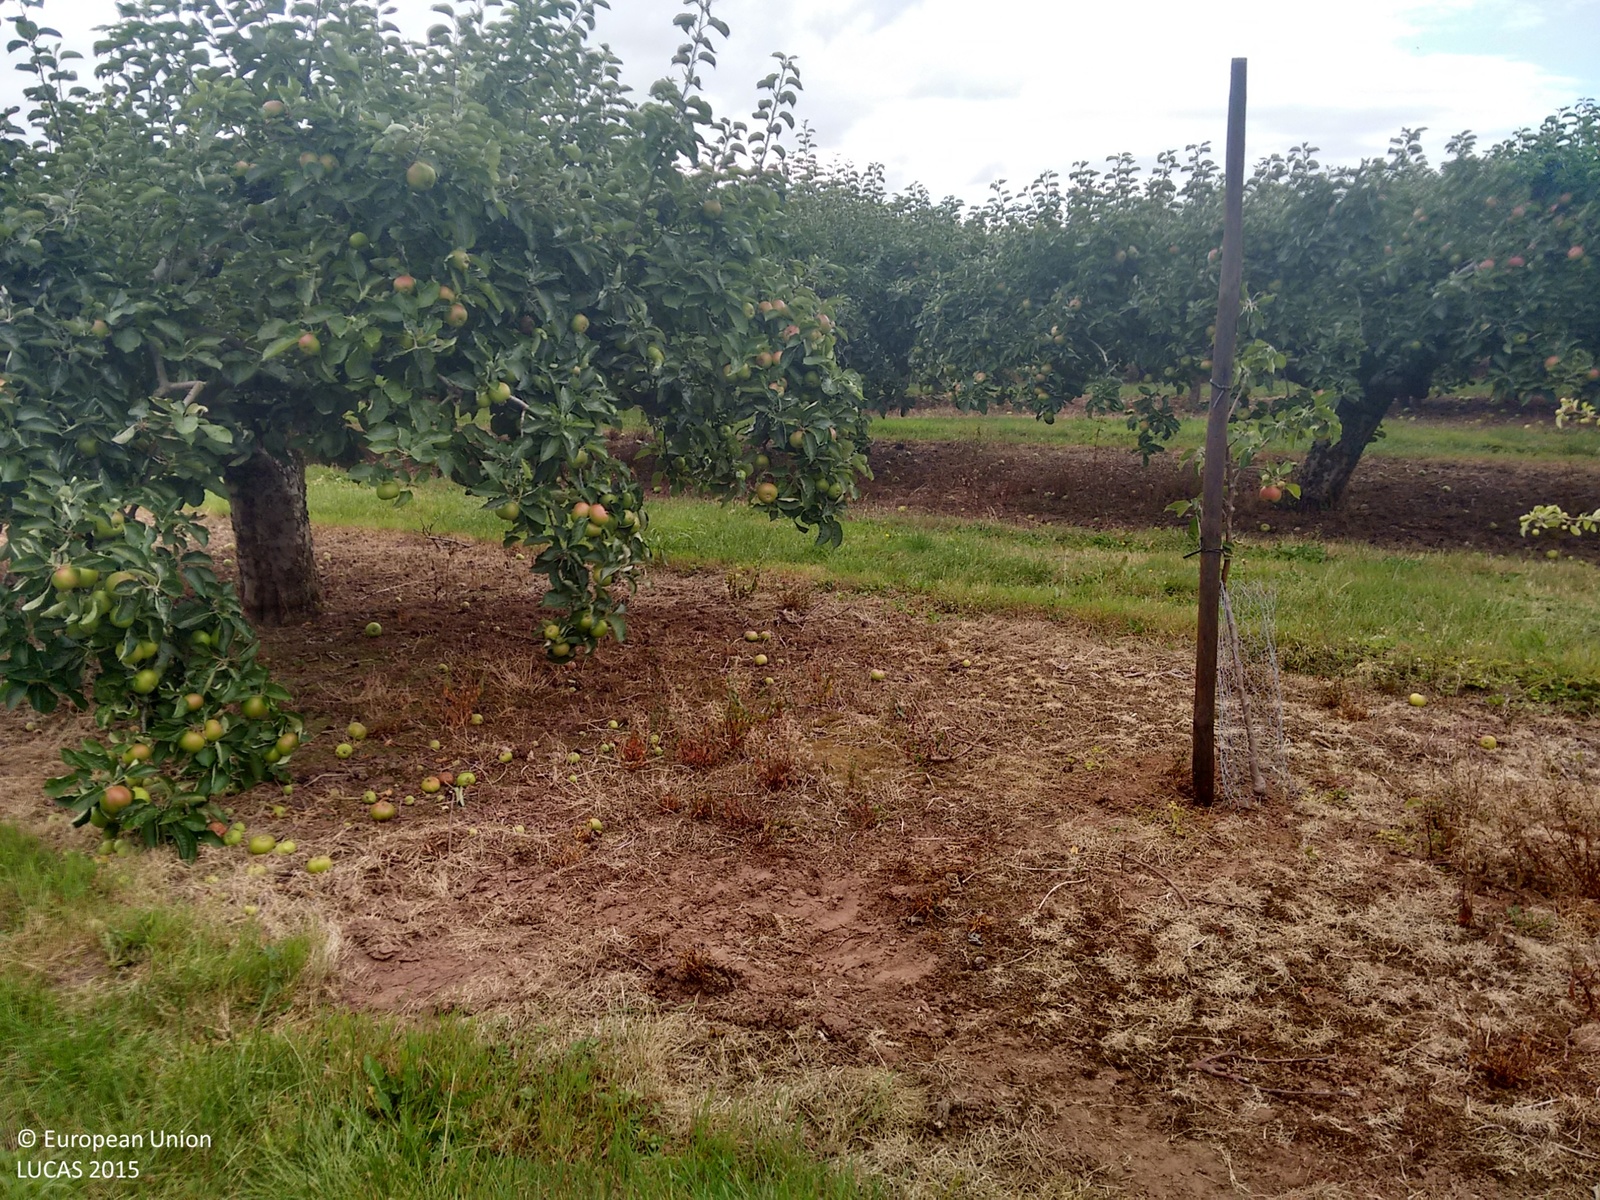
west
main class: Cropland
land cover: Apple fruit
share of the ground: > 75 %
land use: Agriculture (excluding fallow land and kitchen gardens)
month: August
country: GB
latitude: 51.9631
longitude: -2.7174
